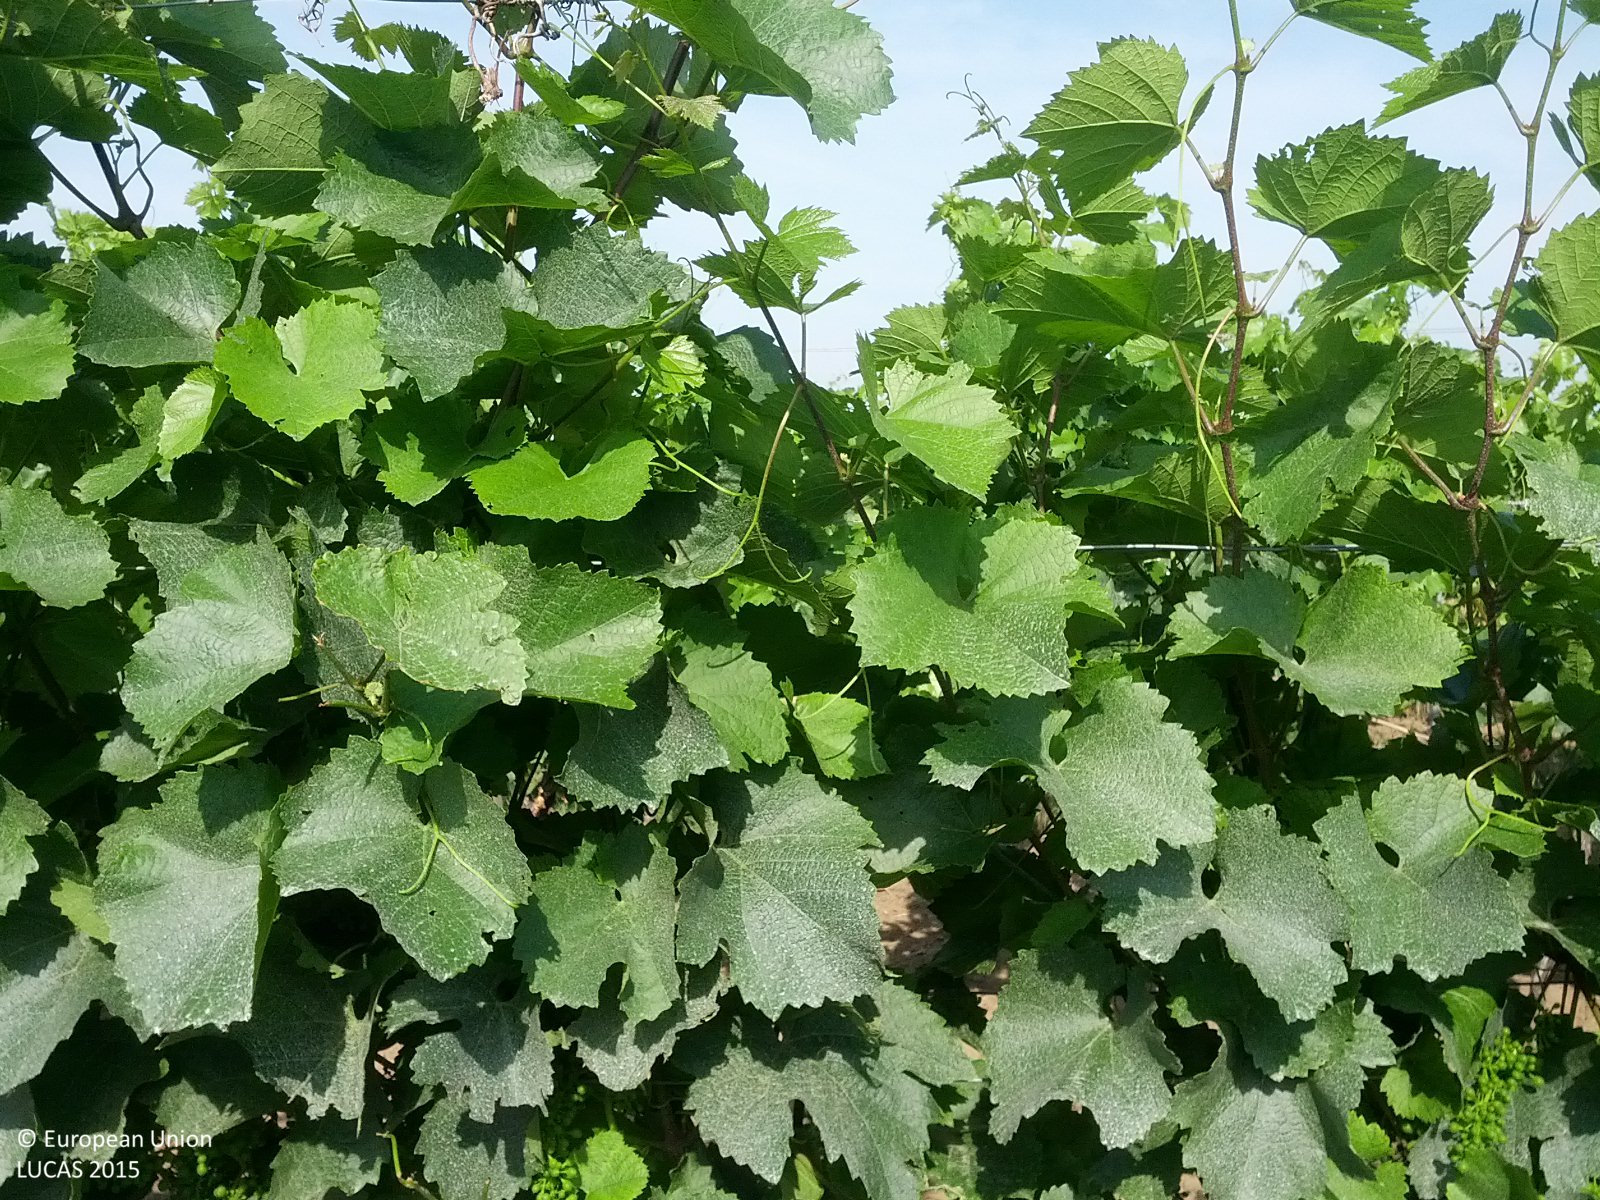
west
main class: Cropland
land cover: Vineyards
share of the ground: 10 - 25 %
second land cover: Other bare soil
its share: > 75 %
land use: Agriculture (excluding fallow land and kitchen gardens)
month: June
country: AT
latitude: 48.6728
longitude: 16.6475
